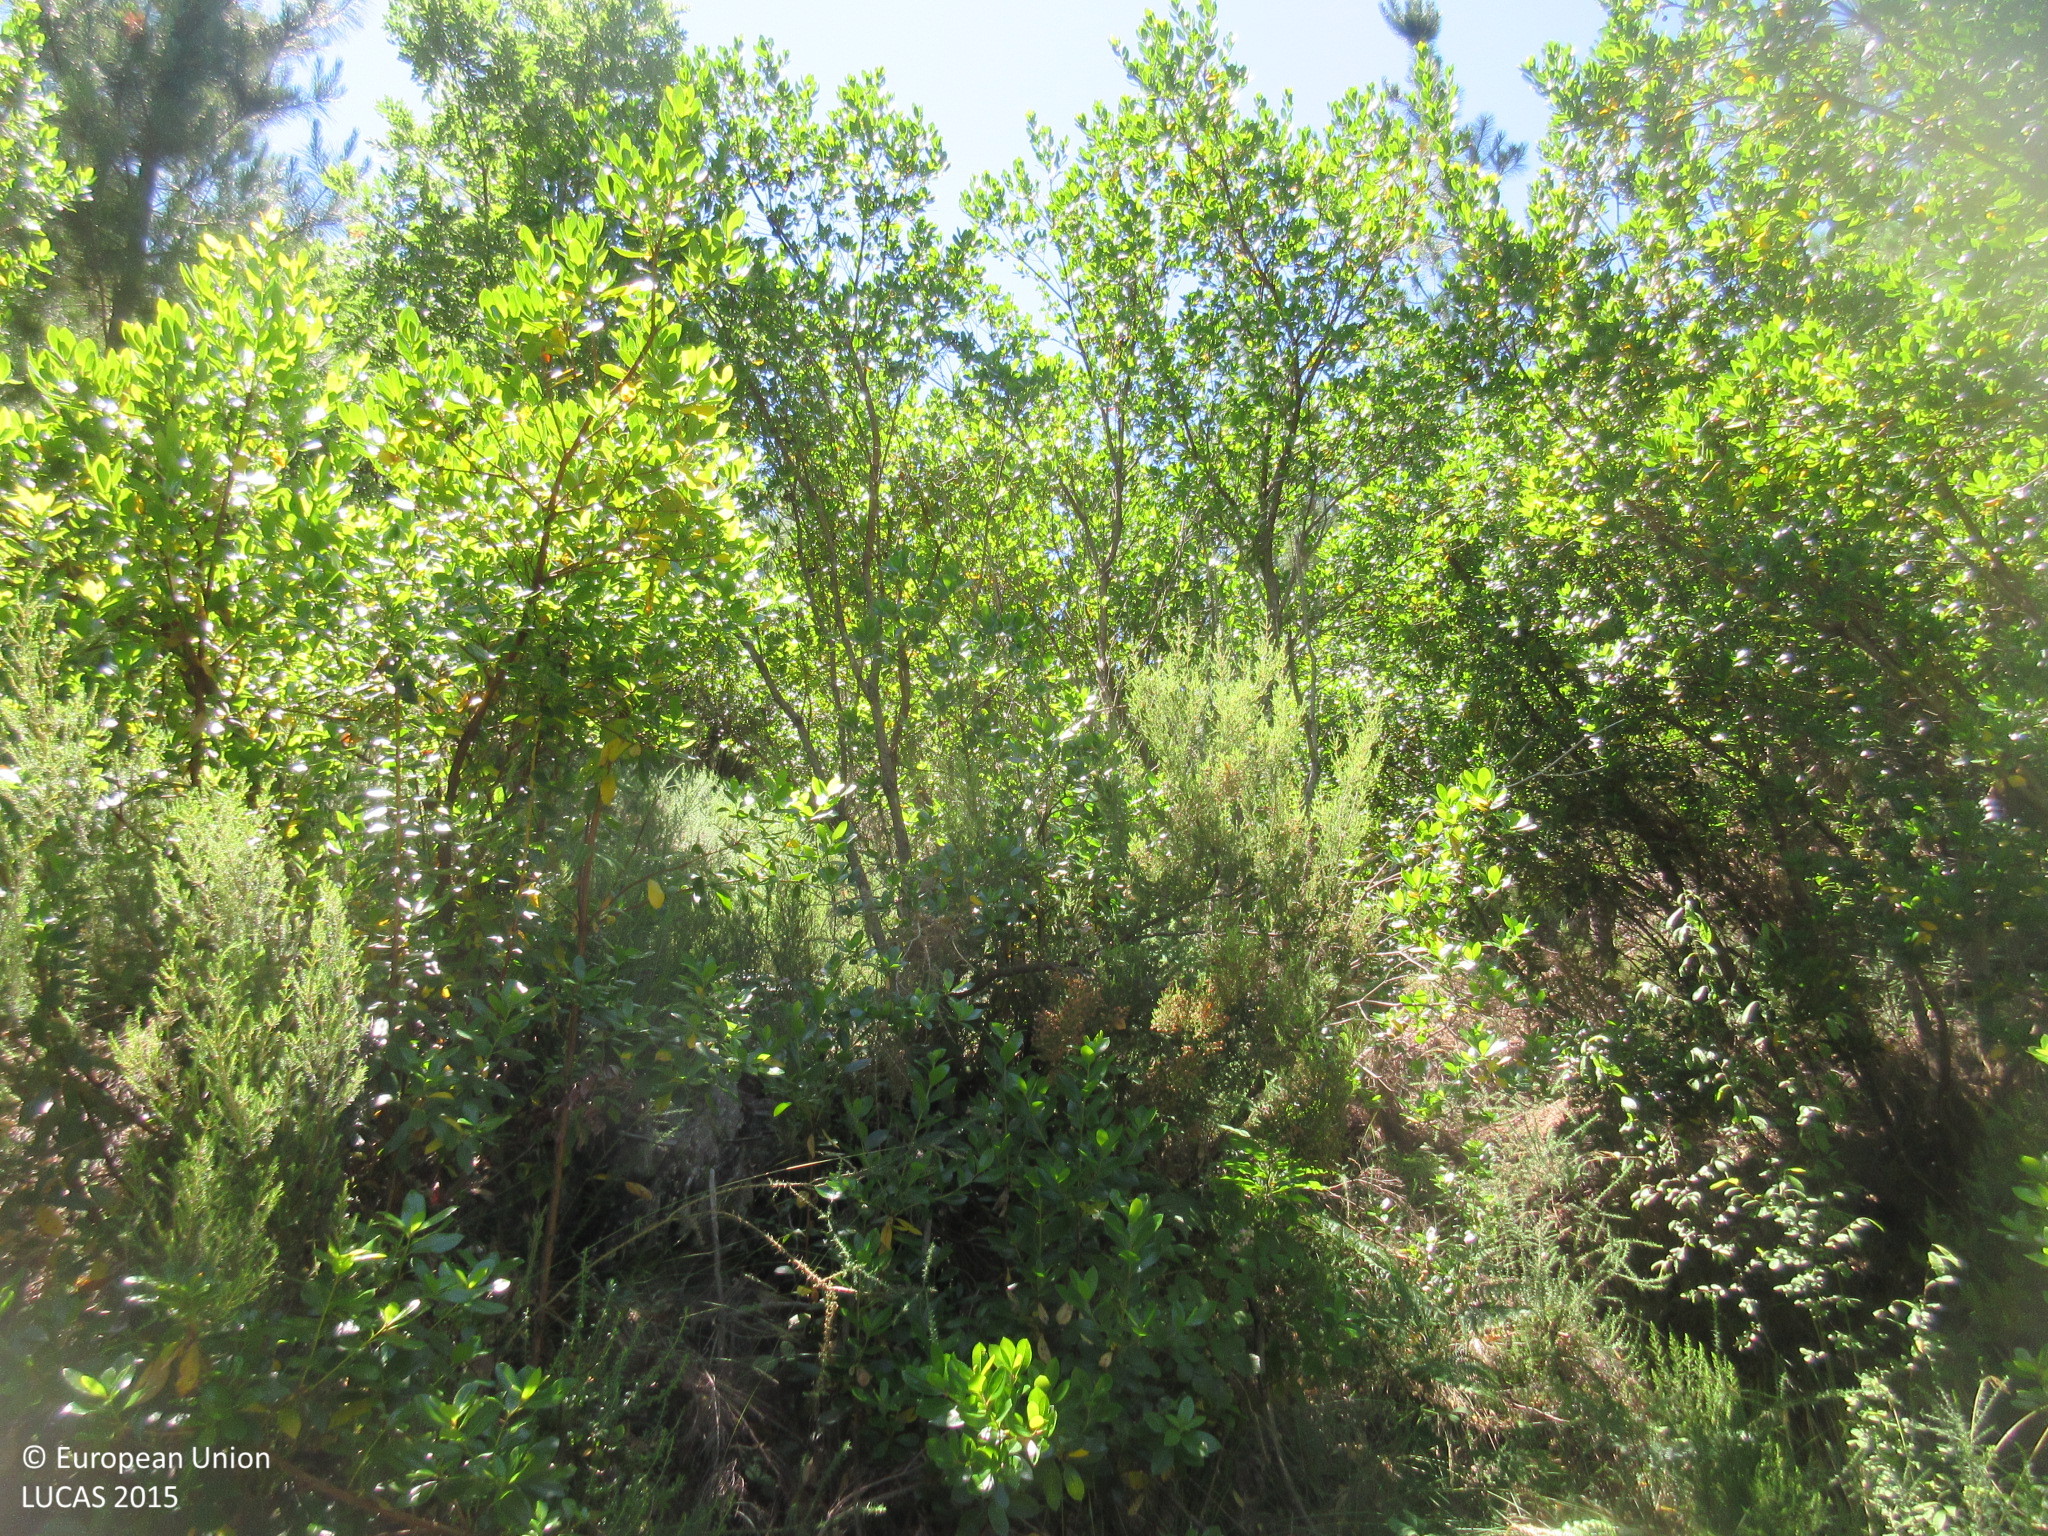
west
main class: Woodland
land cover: Pine dominated coniferous woodland
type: hemiboreal forest and nemoral coniferous forest and mixed broadleaved-coniferous forest
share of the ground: > 75 %
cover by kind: coniferous forest trees 85 %, shrubs 15 %
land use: Forestry
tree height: > 5 m
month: June
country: ES
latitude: 43.0458
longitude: -6.8900
